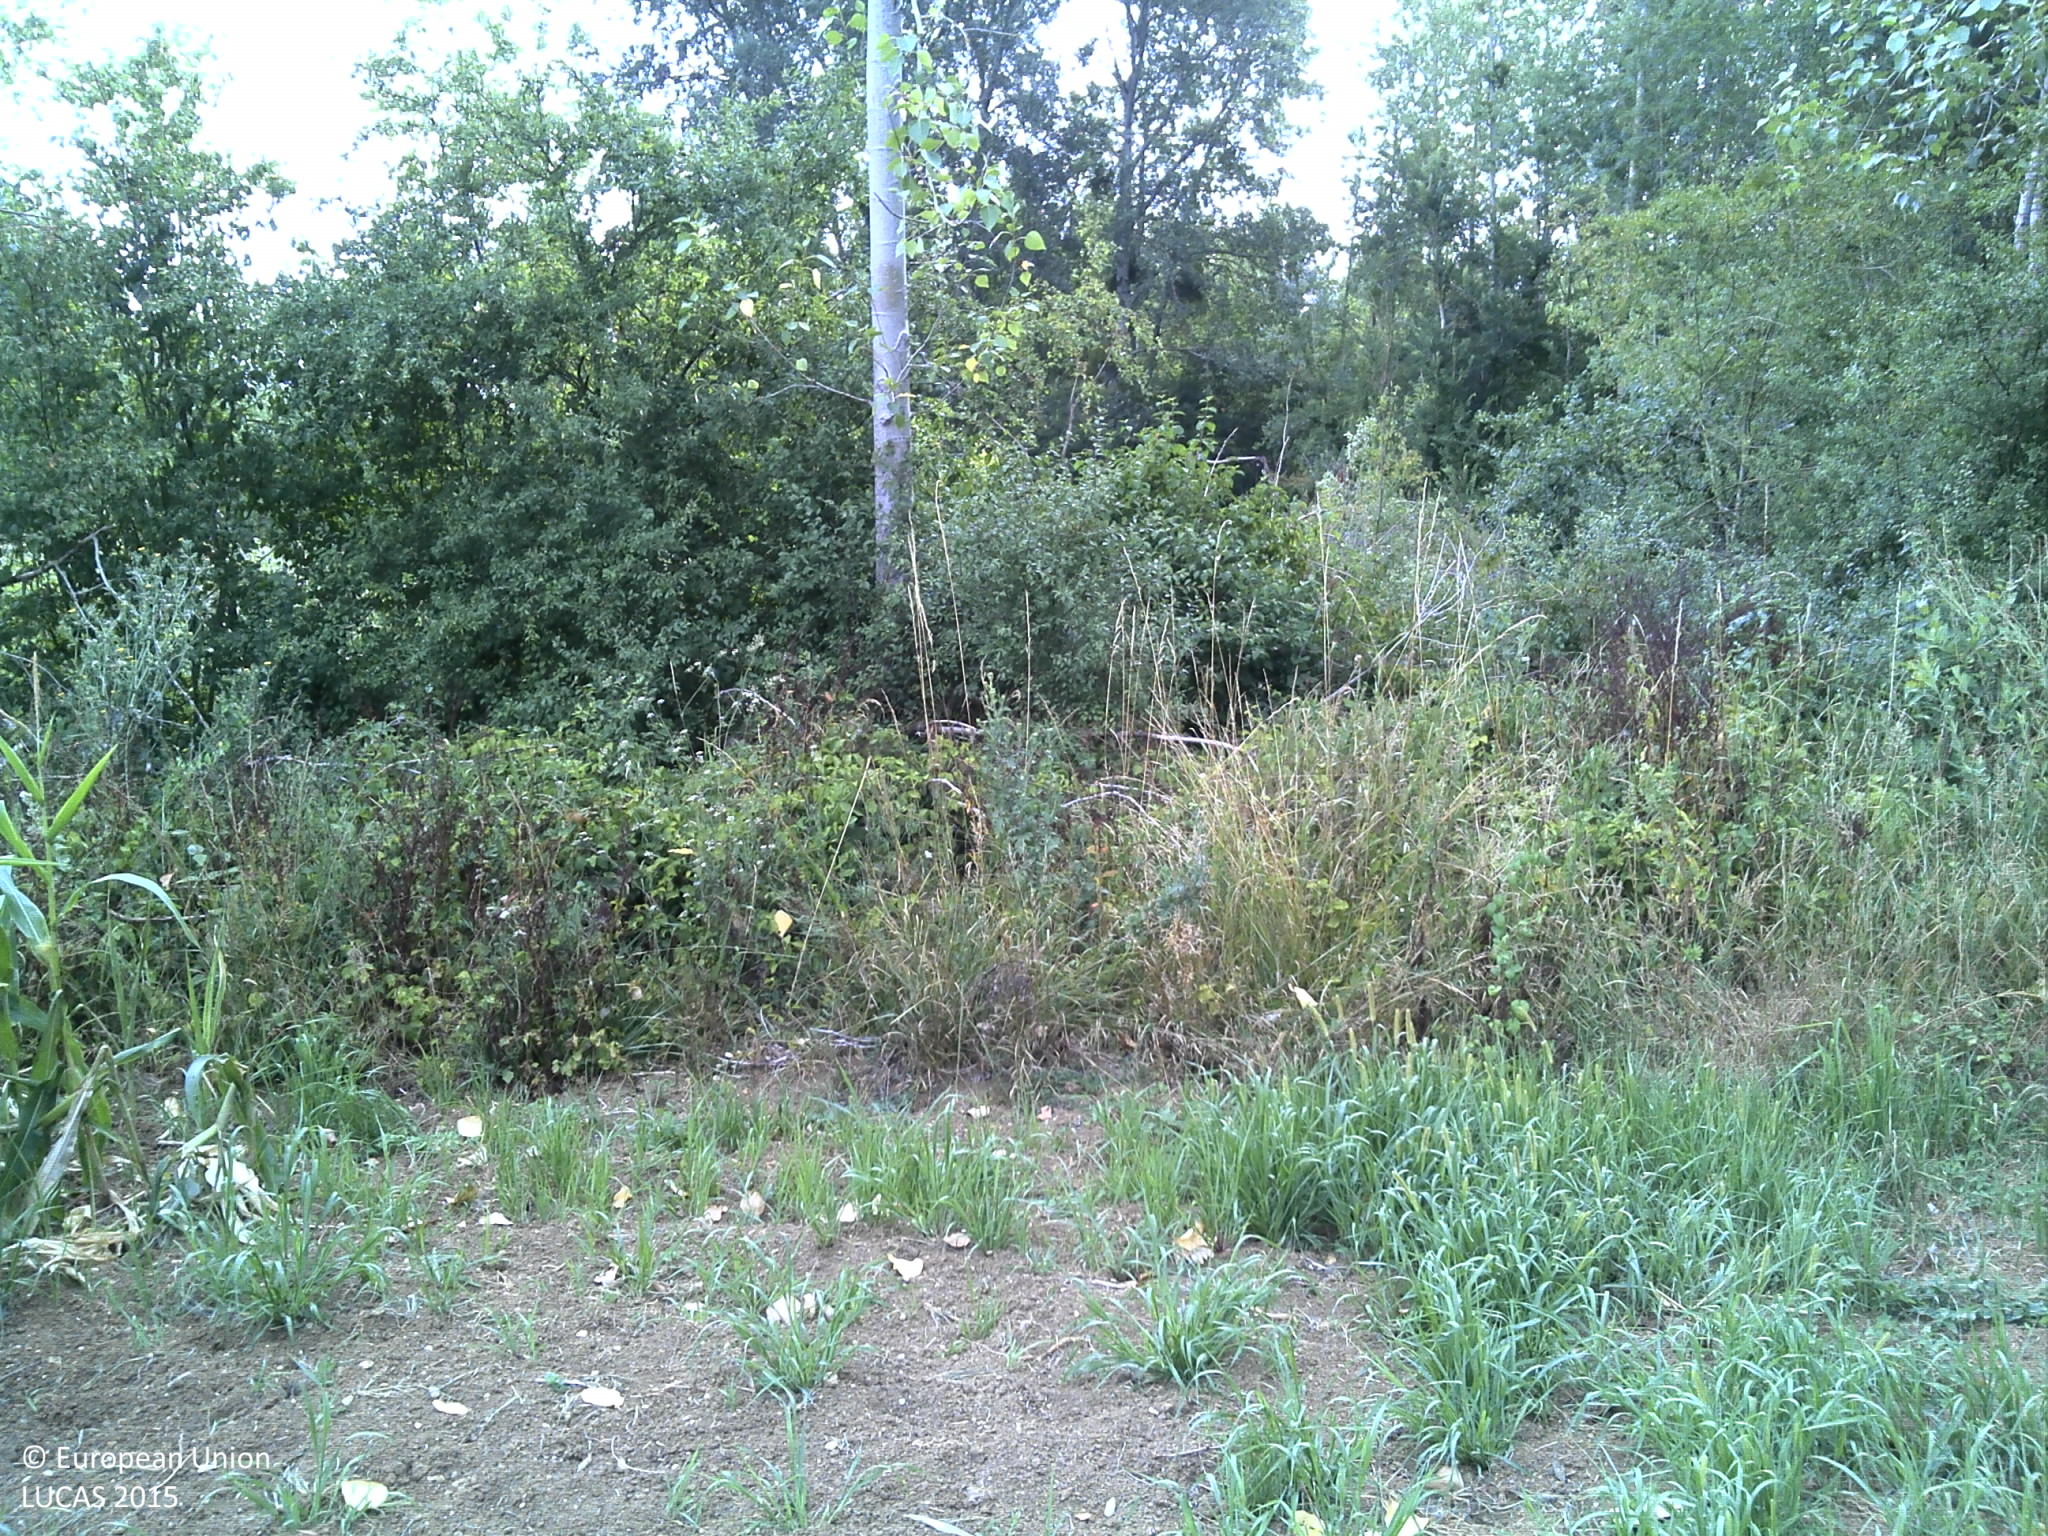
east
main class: Cropland
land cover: Maize
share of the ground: 50 - 75 %
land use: Agriculture (excluding fallow land and kitchen gardens)
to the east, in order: Maize; Broadleaved woodland; Tracks; Broadleaved woodland; Tracks; Broadleaved woodland
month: July
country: FR
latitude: 48.6852
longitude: 4.5775
